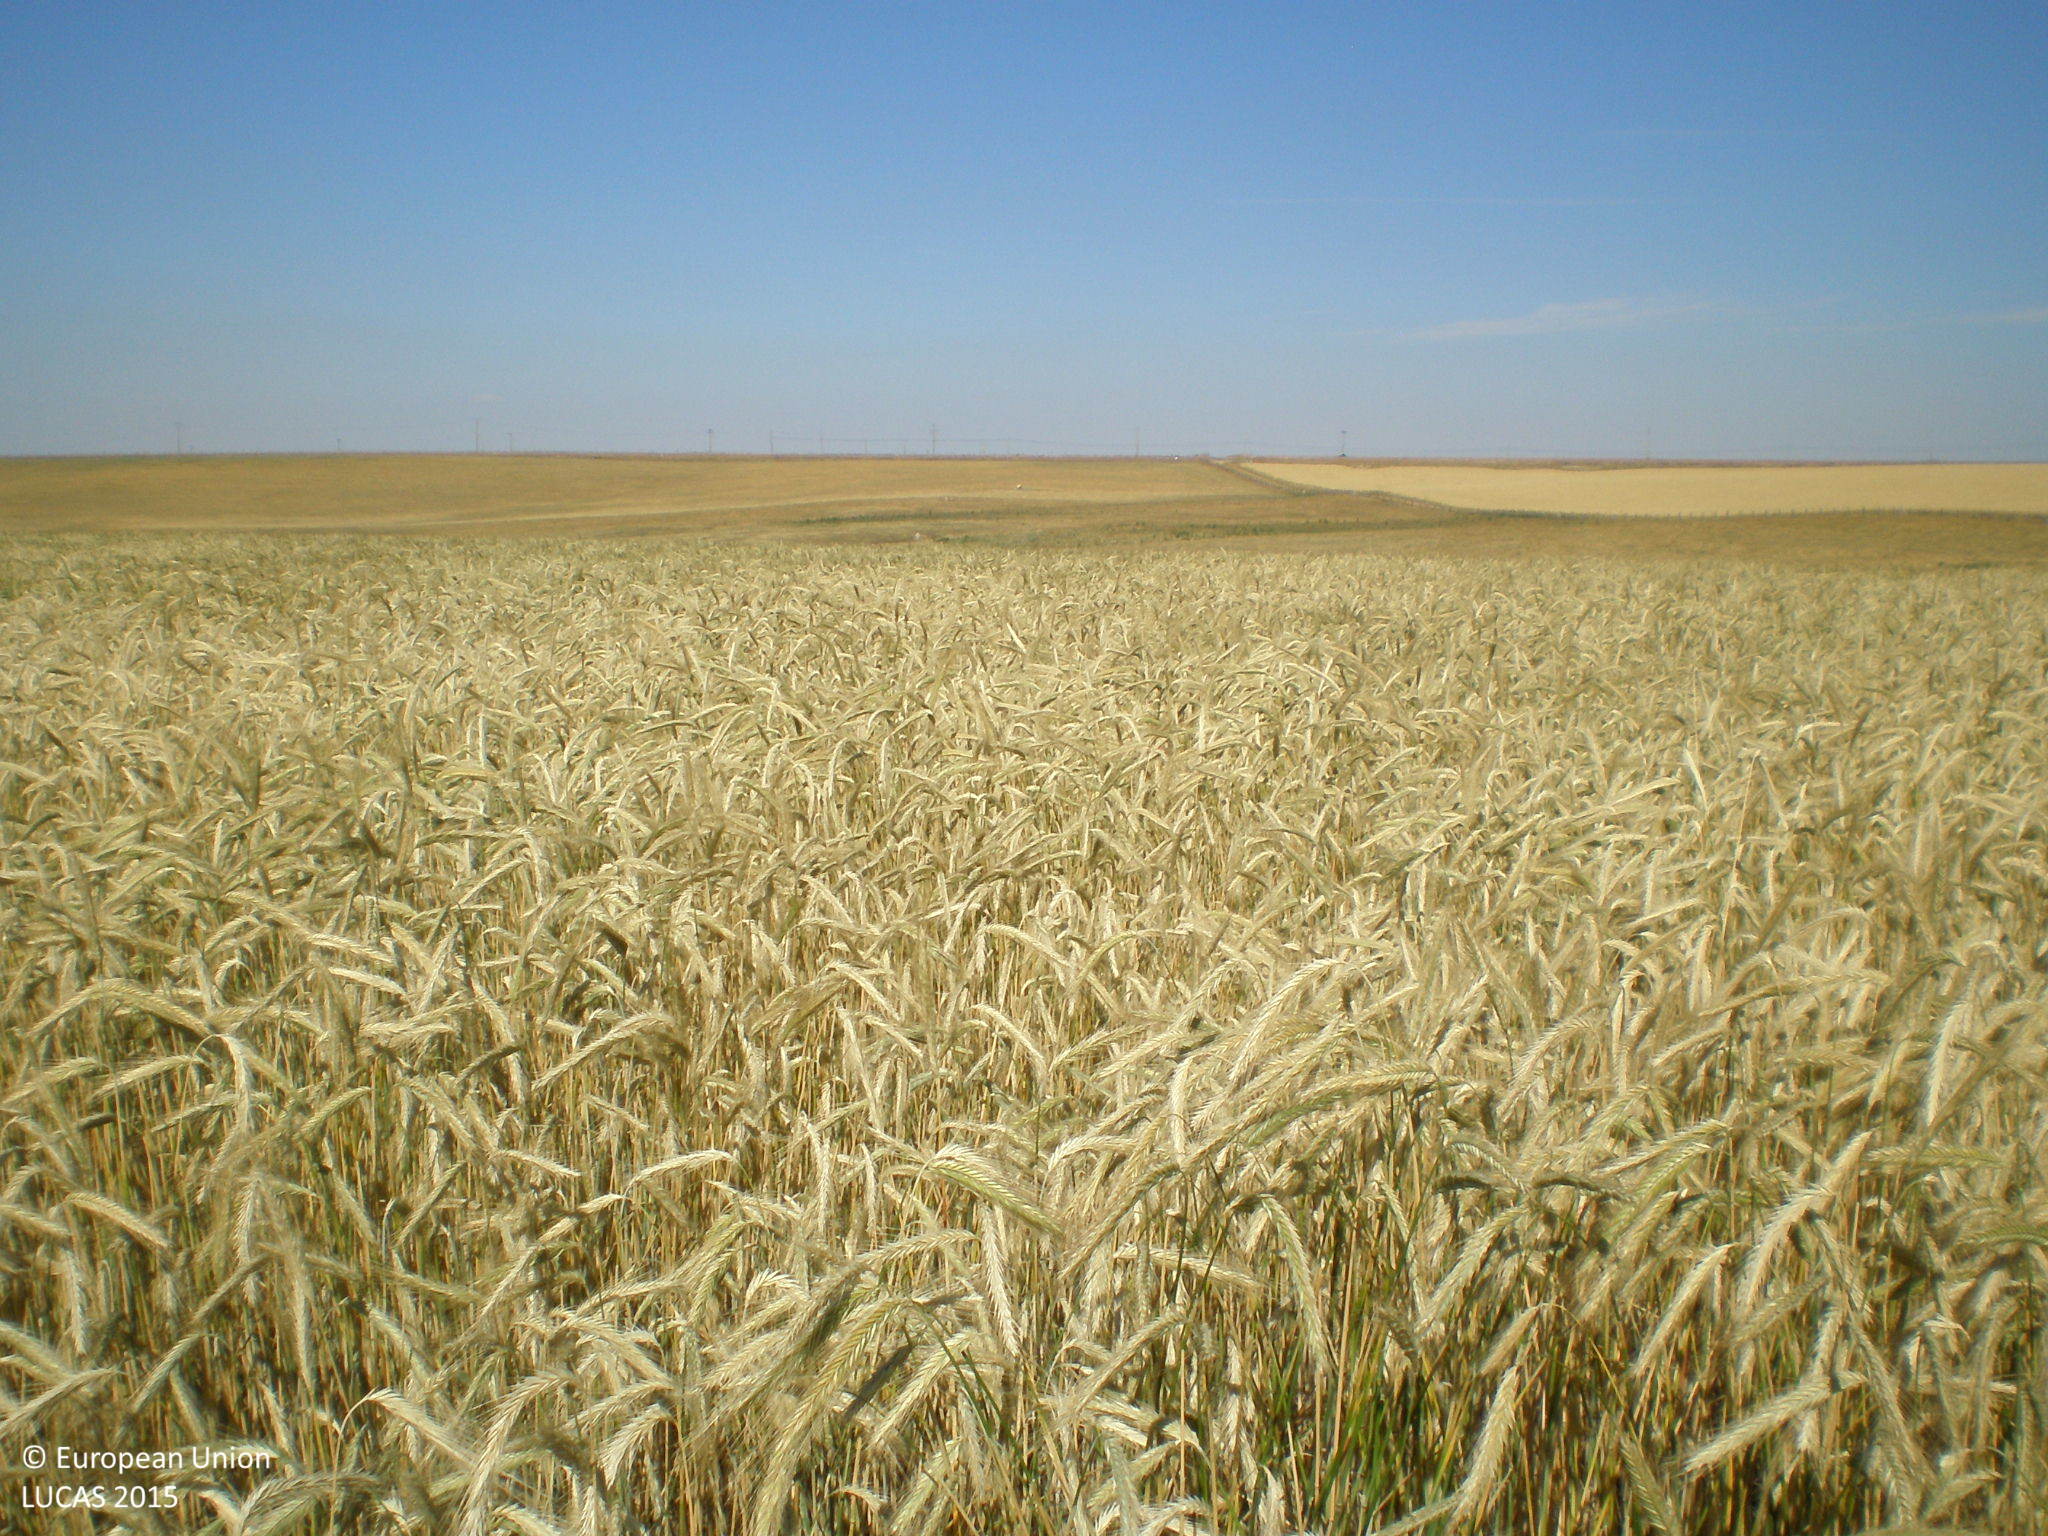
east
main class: Cropland
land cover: Rye
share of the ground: > 75 %
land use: Agriculture (excluding fallow land and kitchen gardens)
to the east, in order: Rye; Grass margins; Fences; Grassland without tree/shrub cover; Inland fresh water bodies; Grassland without tree/shrub cover
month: June
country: ES
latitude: 40.8478
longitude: -5.7217
